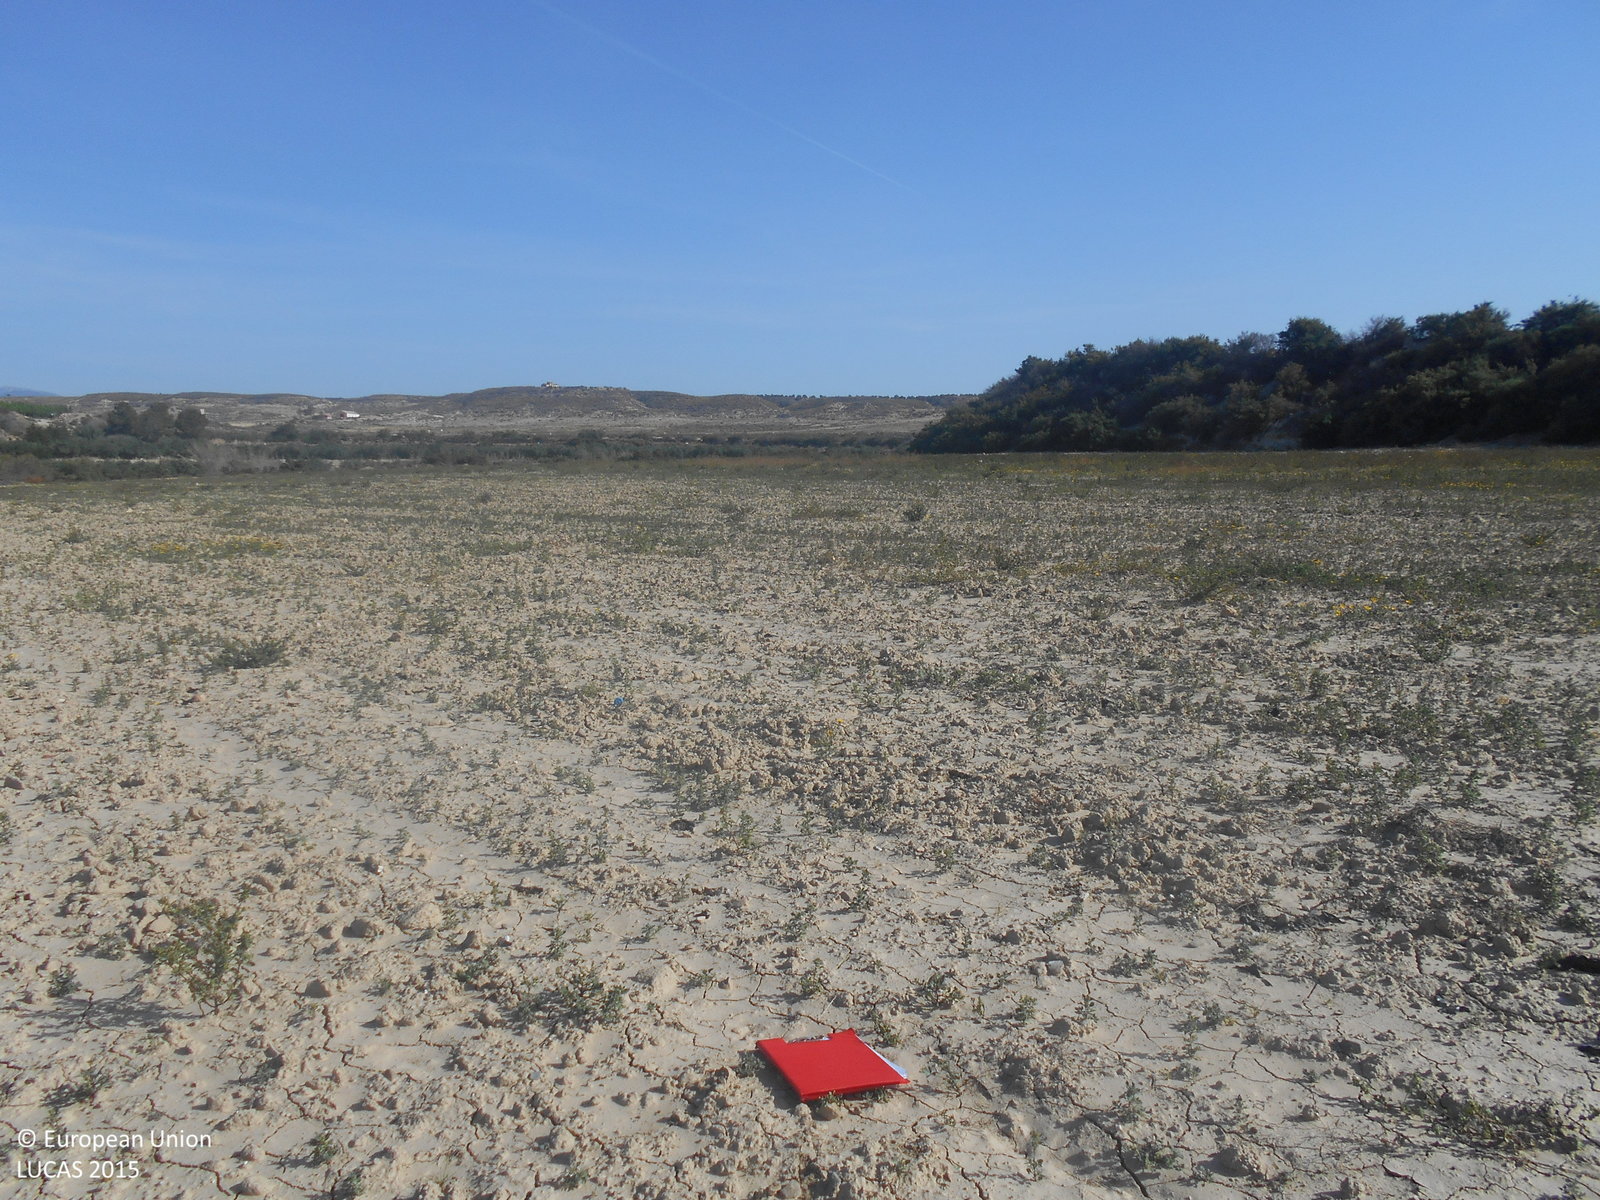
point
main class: Grassland
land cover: Spontaneously vegetated surfaces
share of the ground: 10 - 25 %
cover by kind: unconsolidated bare surface 80 %, herbaceous plants 20 %
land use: Fallow land
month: May
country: ES
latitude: 37.6638
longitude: -1.3967
